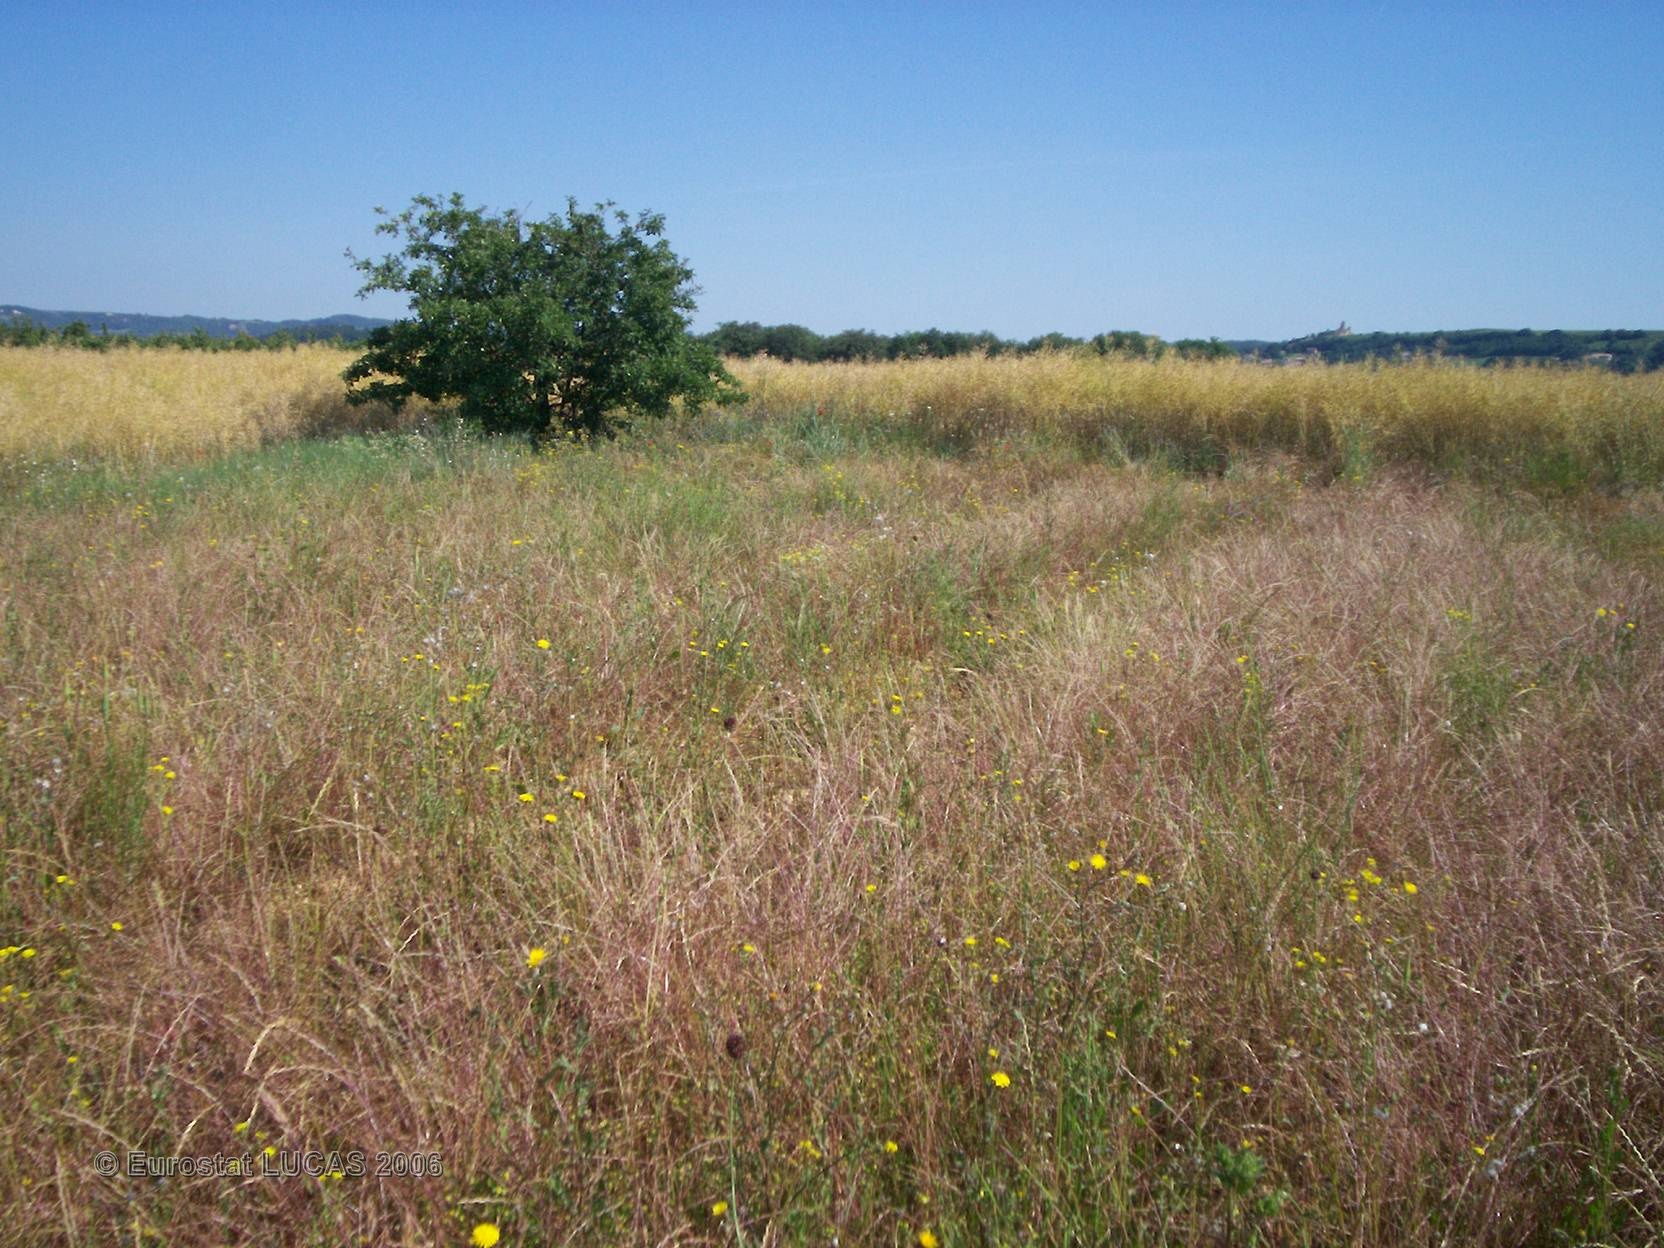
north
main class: Grassland
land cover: Grassland without tree/shrub cover
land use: Fallow land
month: June
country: FR
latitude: 45.0556
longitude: 4.8880
